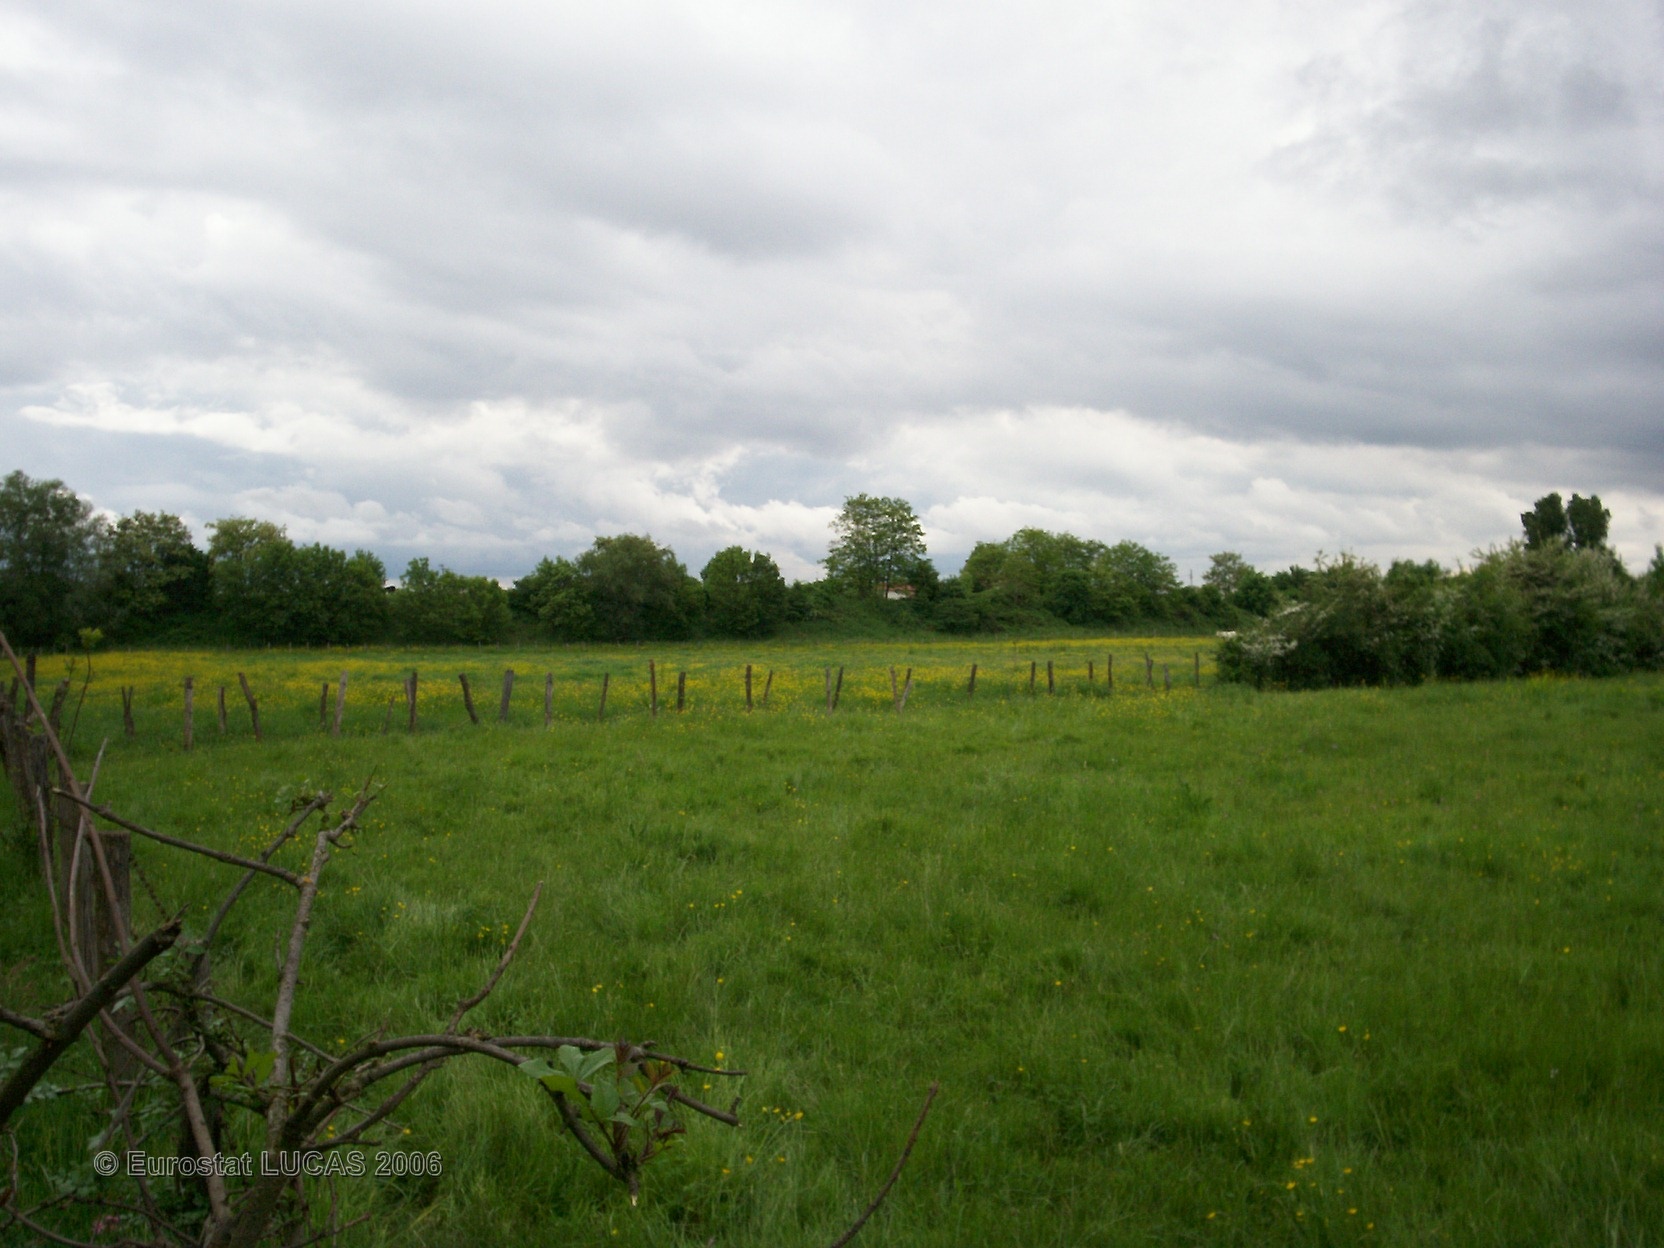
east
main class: Grassland
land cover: Grassland without tree/shrub cover
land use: Agriculture (excluding fallow land and kitchen gardens)
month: May
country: FR
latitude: 45.9170
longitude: 4.7814
